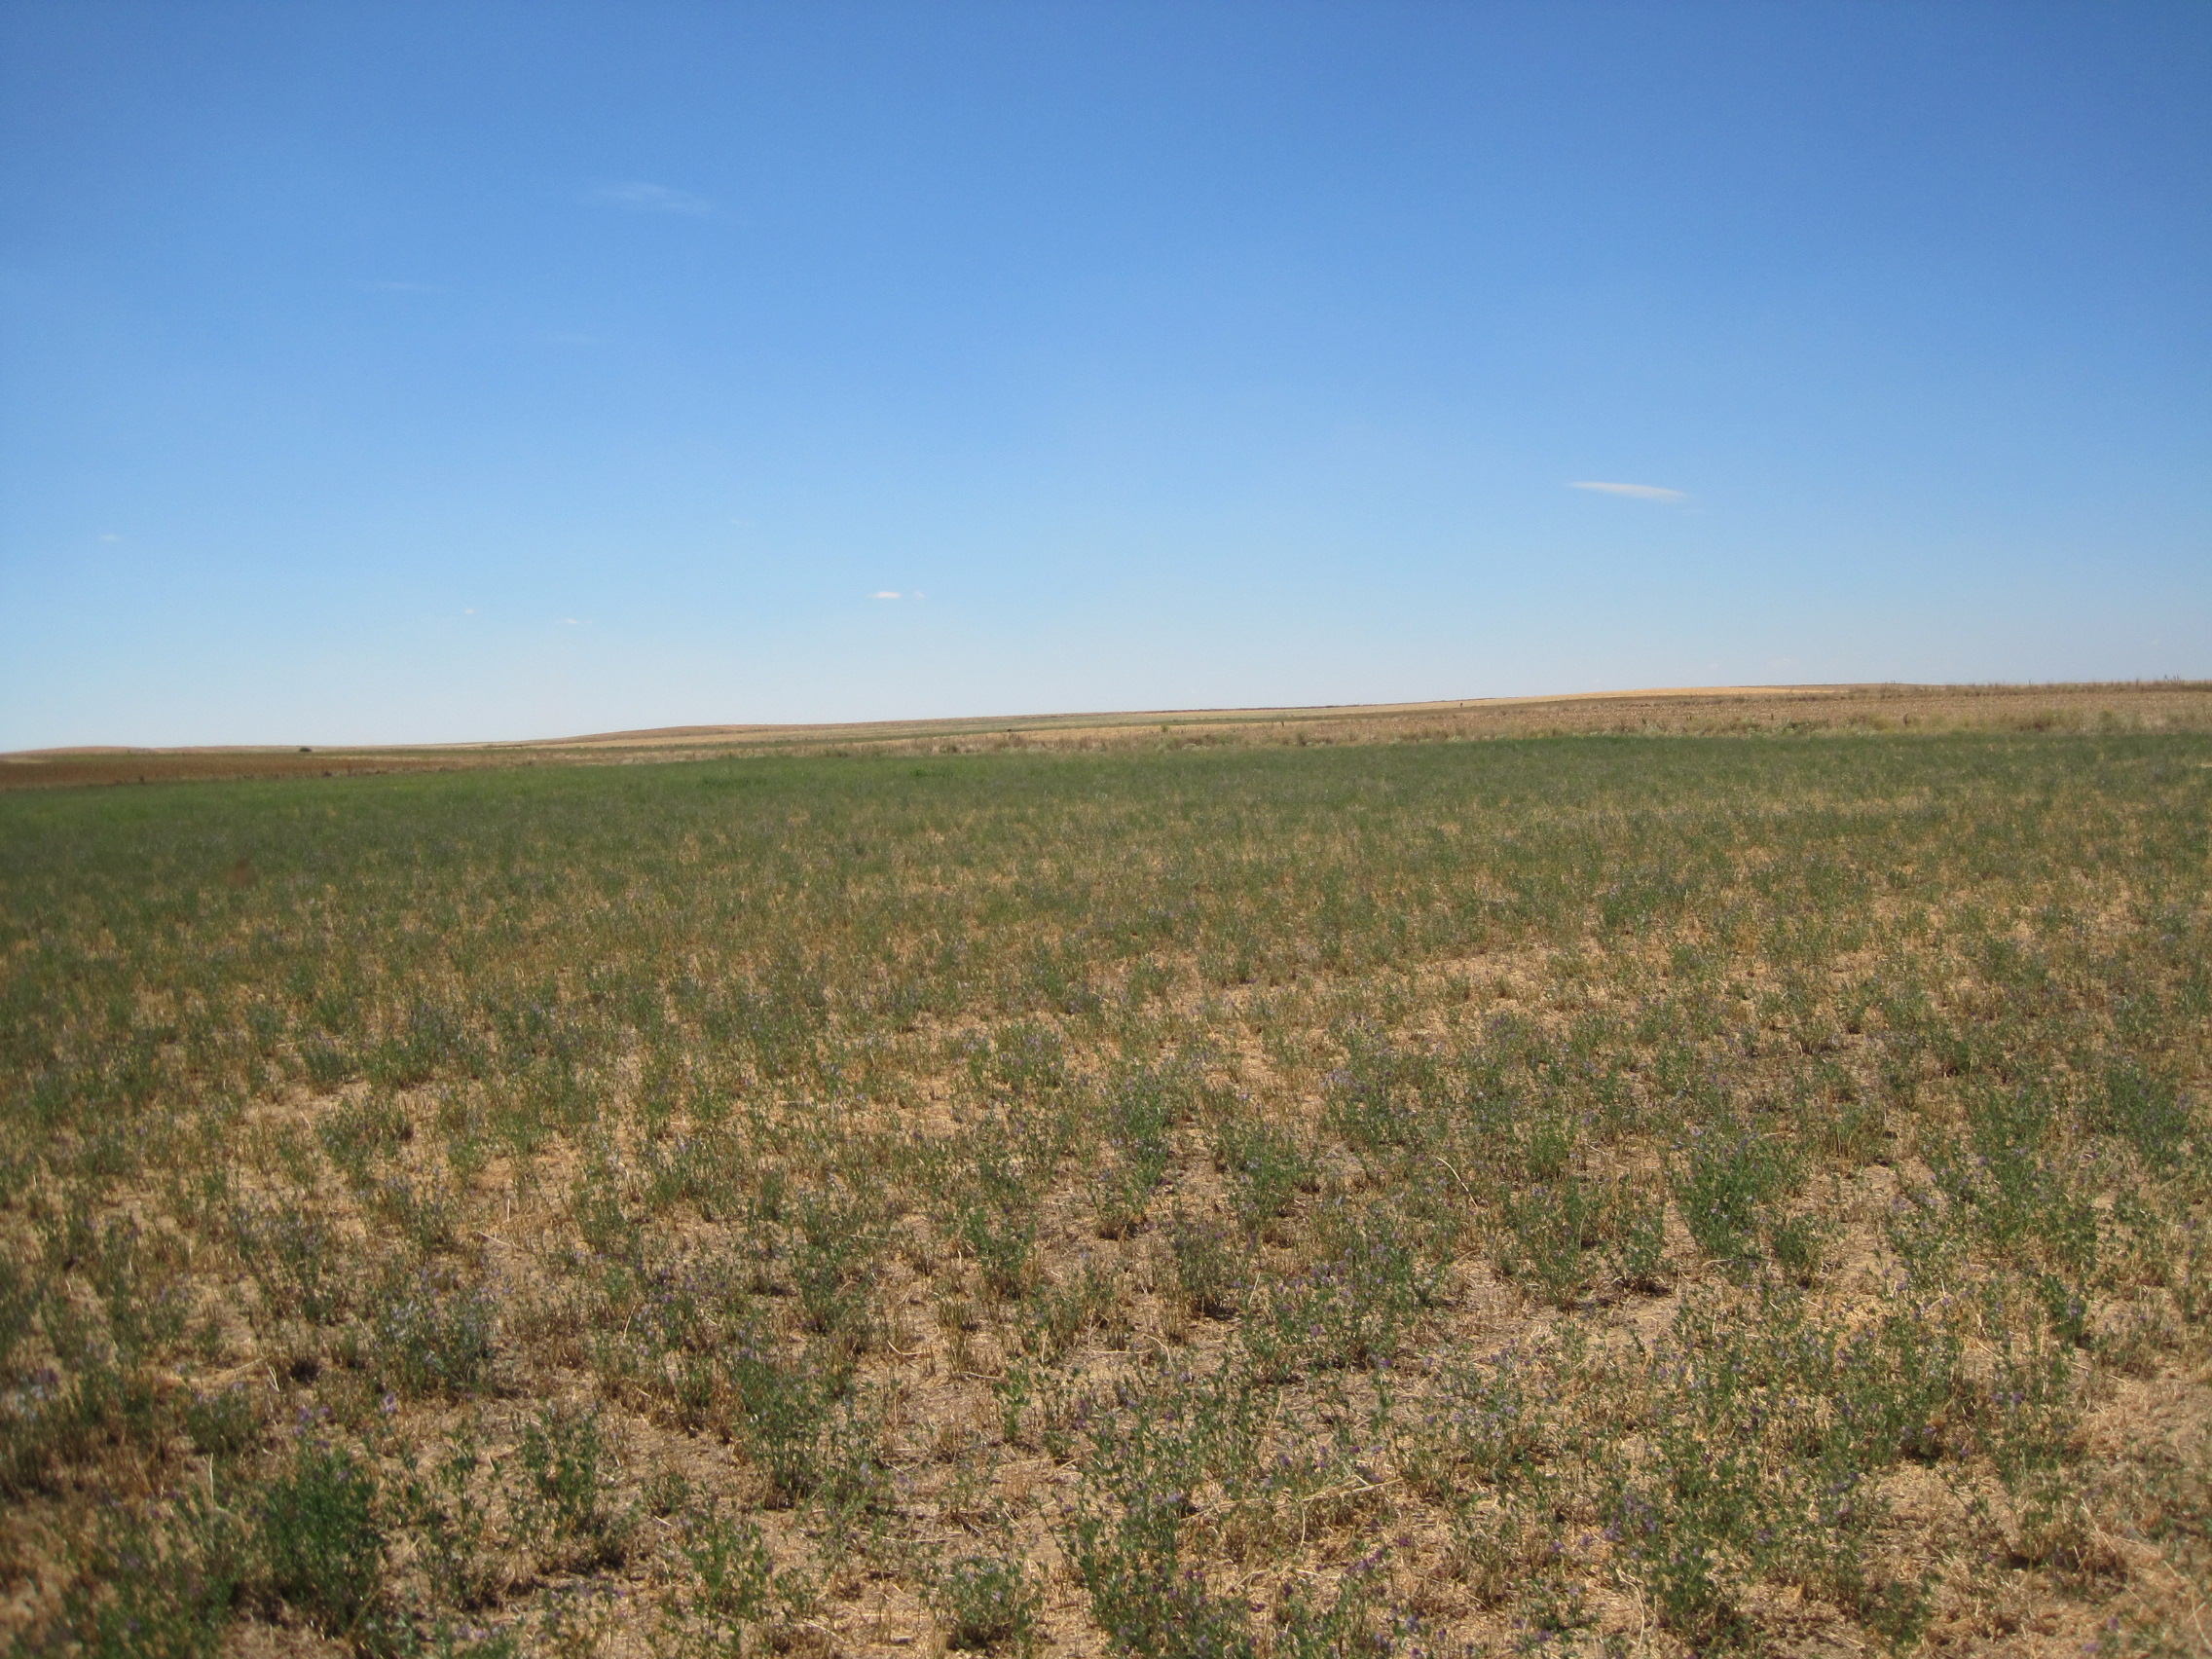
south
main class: Cropland
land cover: Lucerne
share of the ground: > 75 %
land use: Agriculture (excluding fallow land and kitchen gardens)
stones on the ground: < 10 %
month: July
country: ES
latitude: 41.9911
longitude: -5.5768
